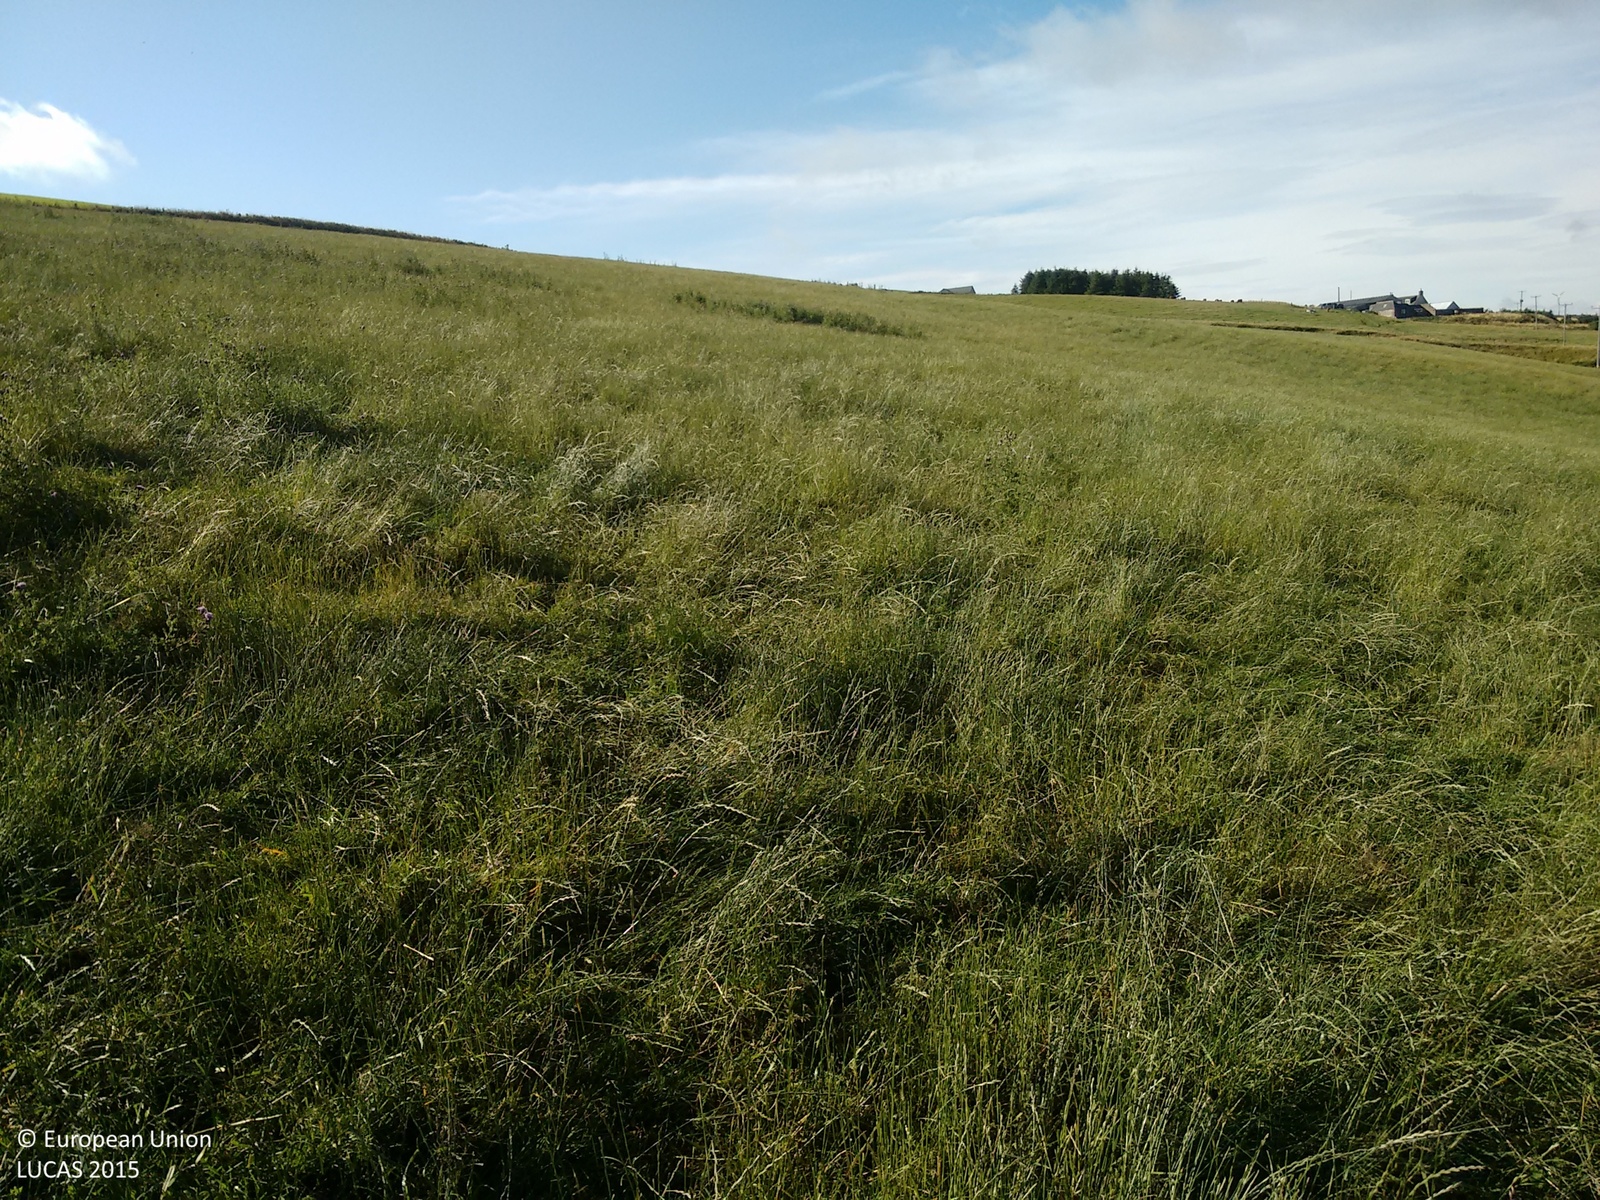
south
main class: Grassland
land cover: Grassland without tree/shrub cover
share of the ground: > 75 %
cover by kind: herbaceous plants 100 %
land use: Agriculture (excluding fallow land and kitchen gardens)
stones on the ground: < 10 %
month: August
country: GB
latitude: 57.6666
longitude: -2.3371
